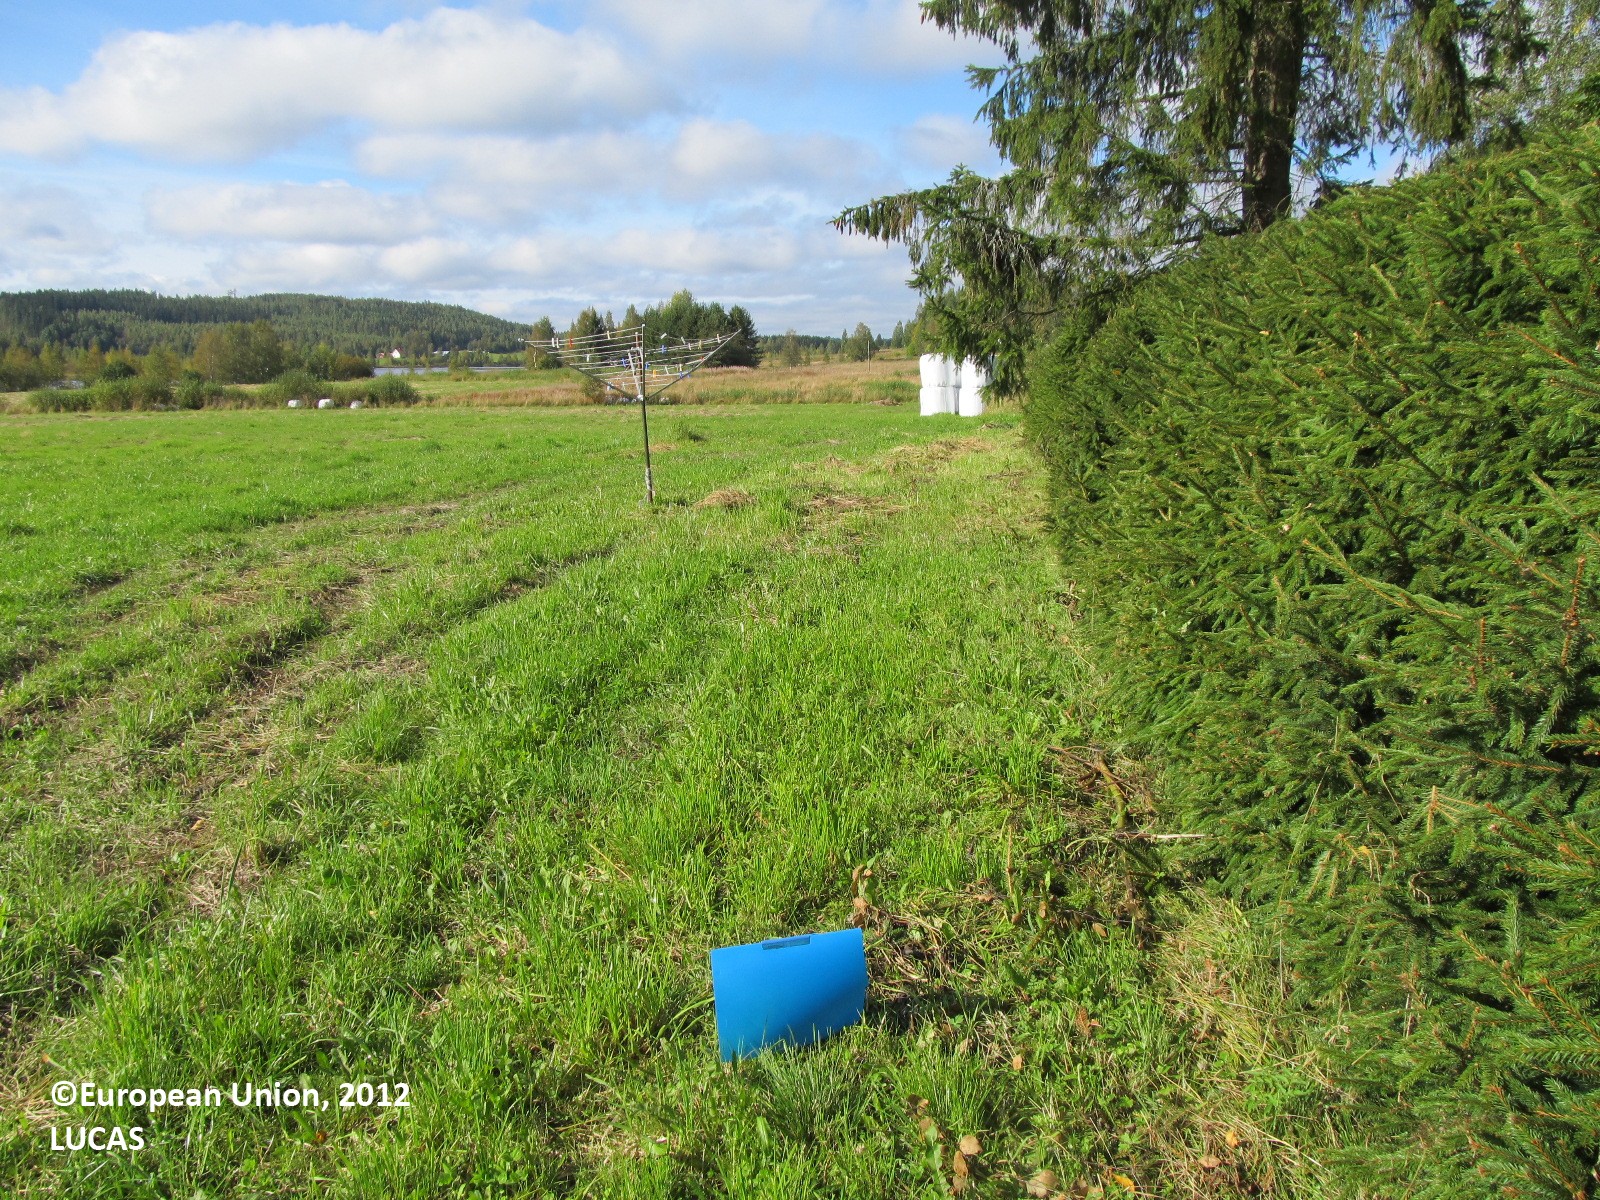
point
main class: Cropland
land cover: Temporary grasslands
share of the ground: 50 - 75 %
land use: Agriculture (excluding fallow land and kitchen gardens)
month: September
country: FI
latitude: 62.9723
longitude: 28.2347
